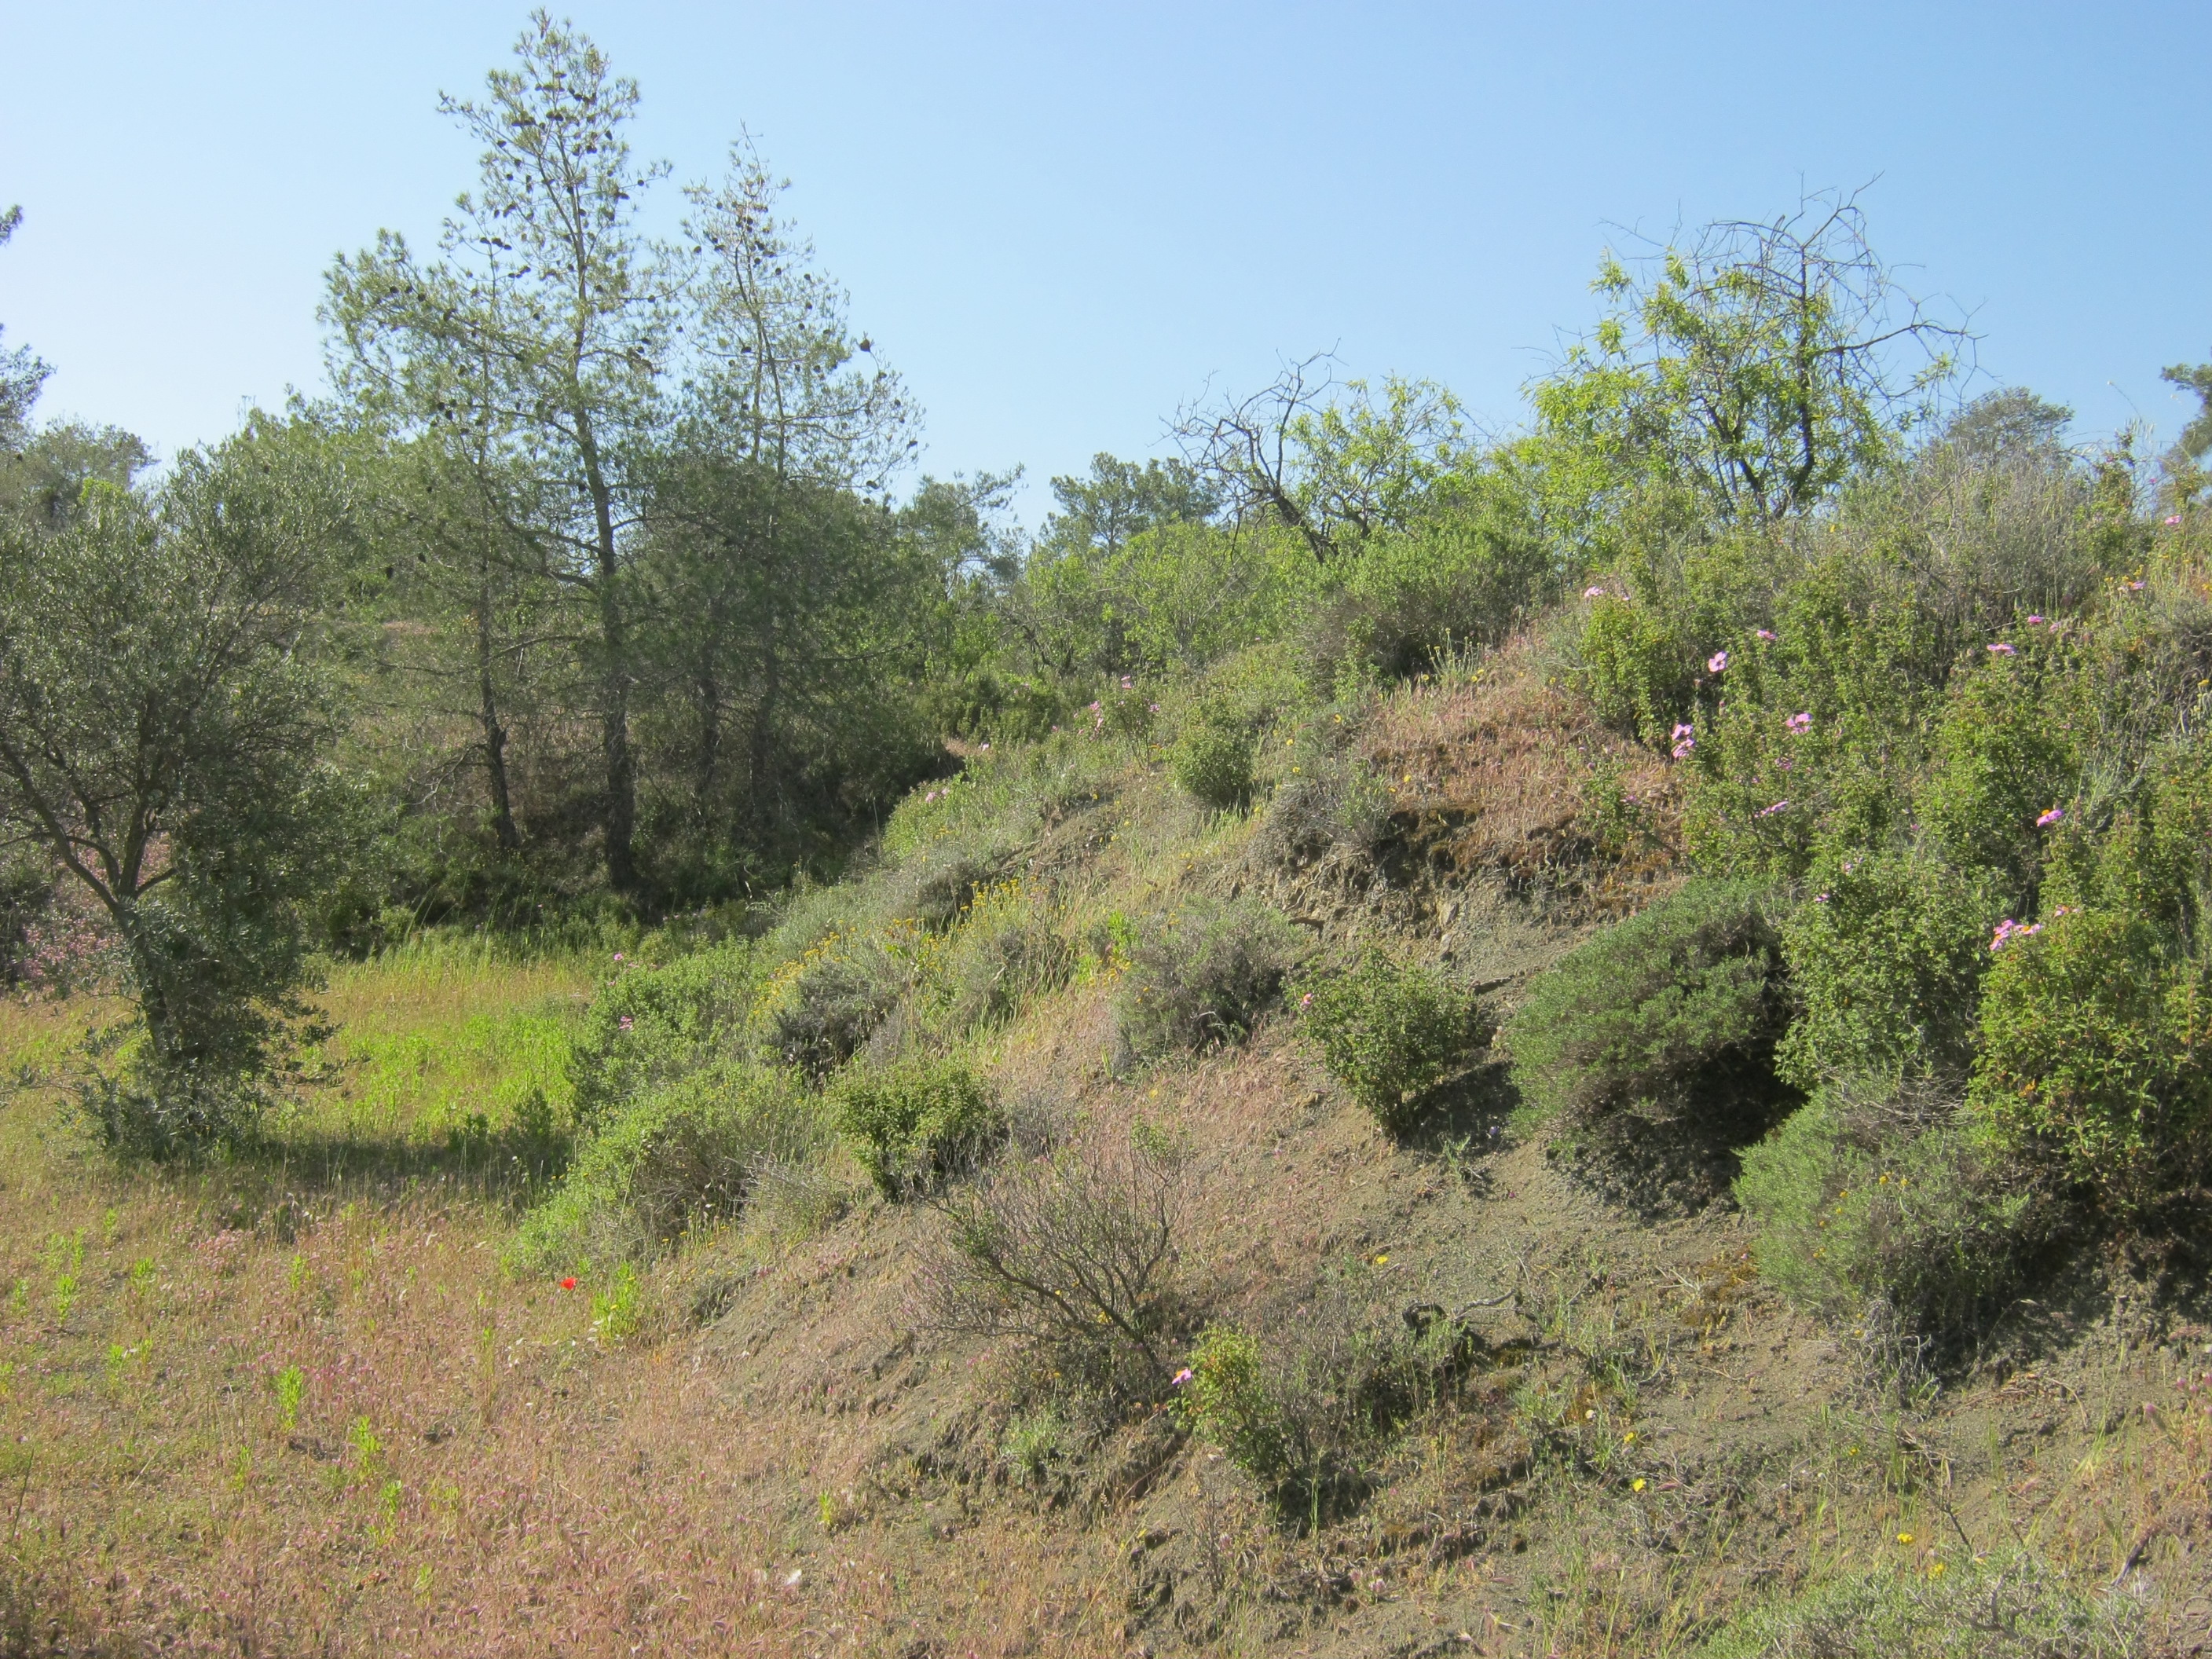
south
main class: Woodland
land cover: Pine dominated coniferous woodland
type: coniferous forest of the mediterranean region
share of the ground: 25 - 50 %
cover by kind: herbaceous plants 65 %, coniferous forest trees 25 %, broadleaved forest trees 5 %, unconsolidated bare surface 5 %
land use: Semi-natural and natural areas not in use
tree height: > 5 m
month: April
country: CY
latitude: 34.9826
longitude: 33.2876
